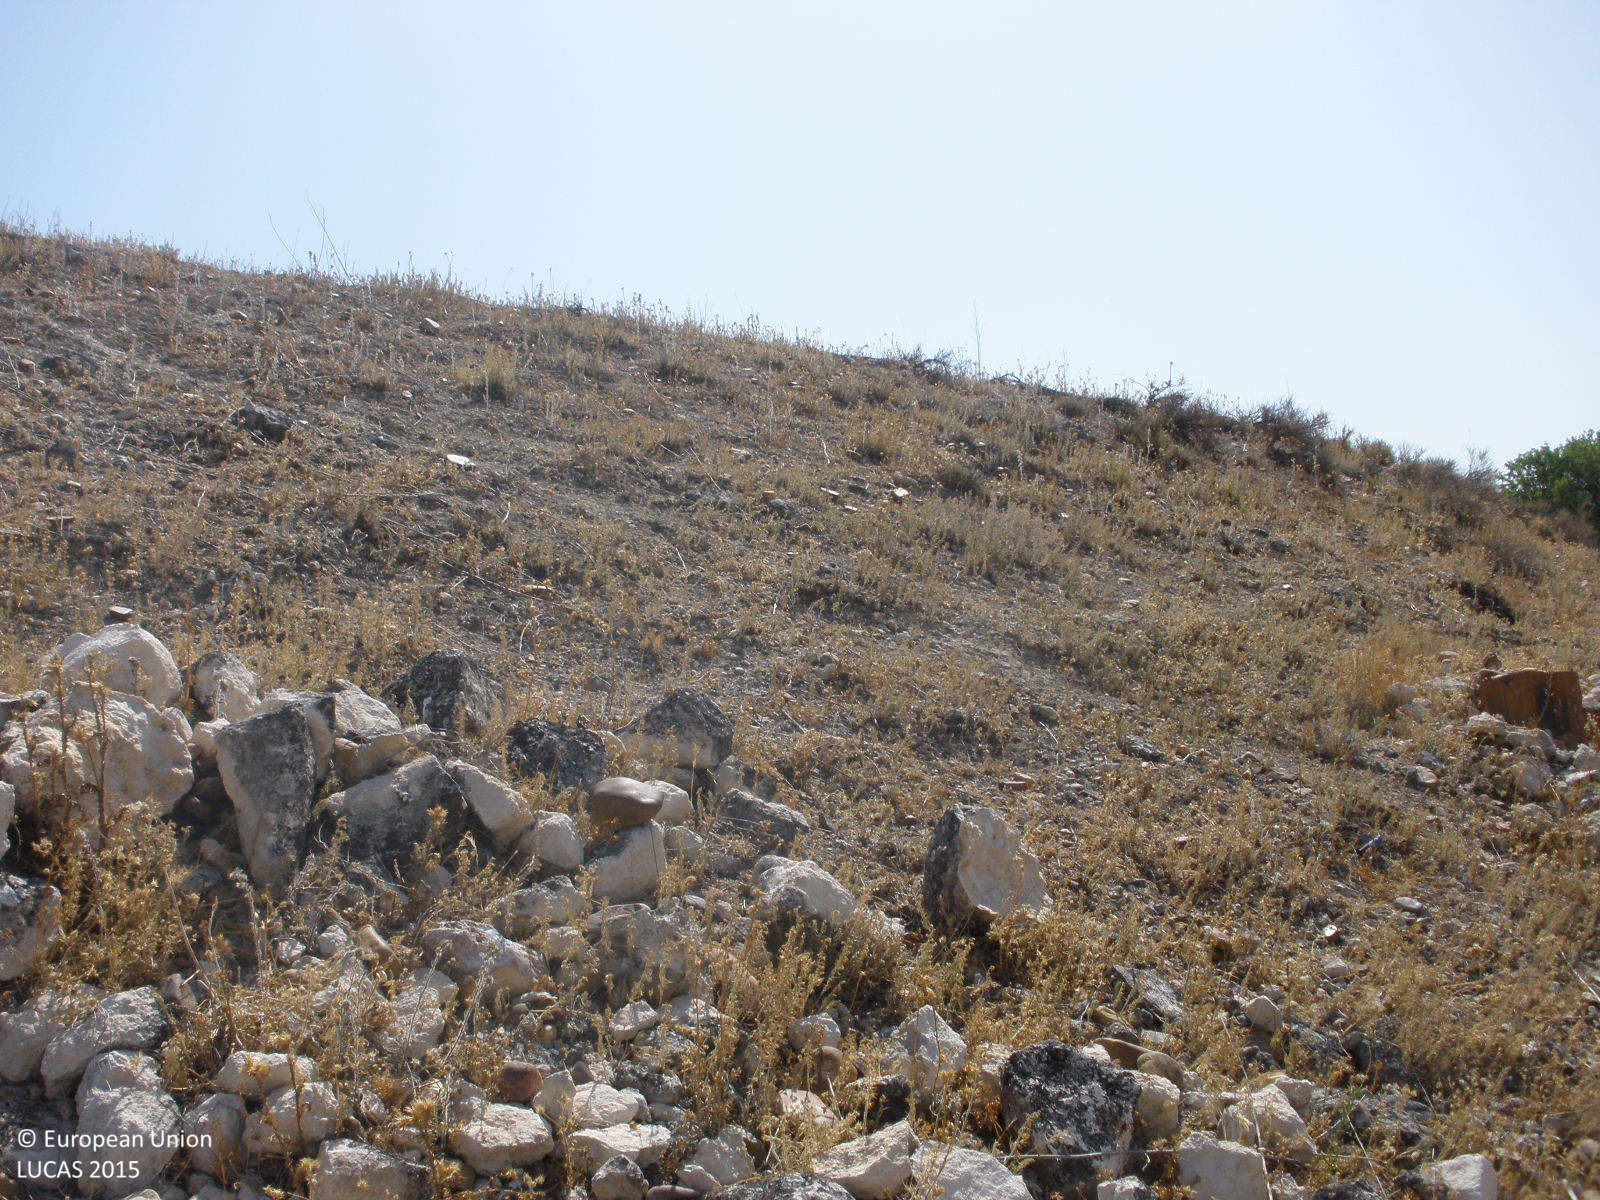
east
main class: Shrubland
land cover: Shrubland without tree cover
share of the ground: 10 - 25 %
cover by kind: herbaceous plants 60 %, shrubs 20 %, consolidated bare surface 20 %
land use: Semi-natural and natural areas not in use
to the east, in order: Shrubland without tree cover; Vineyards; Grass margins; Tracks; Shrubland without tree cover; Olive groves
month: July
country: ES
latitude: 40.2882
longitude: -3.4541
